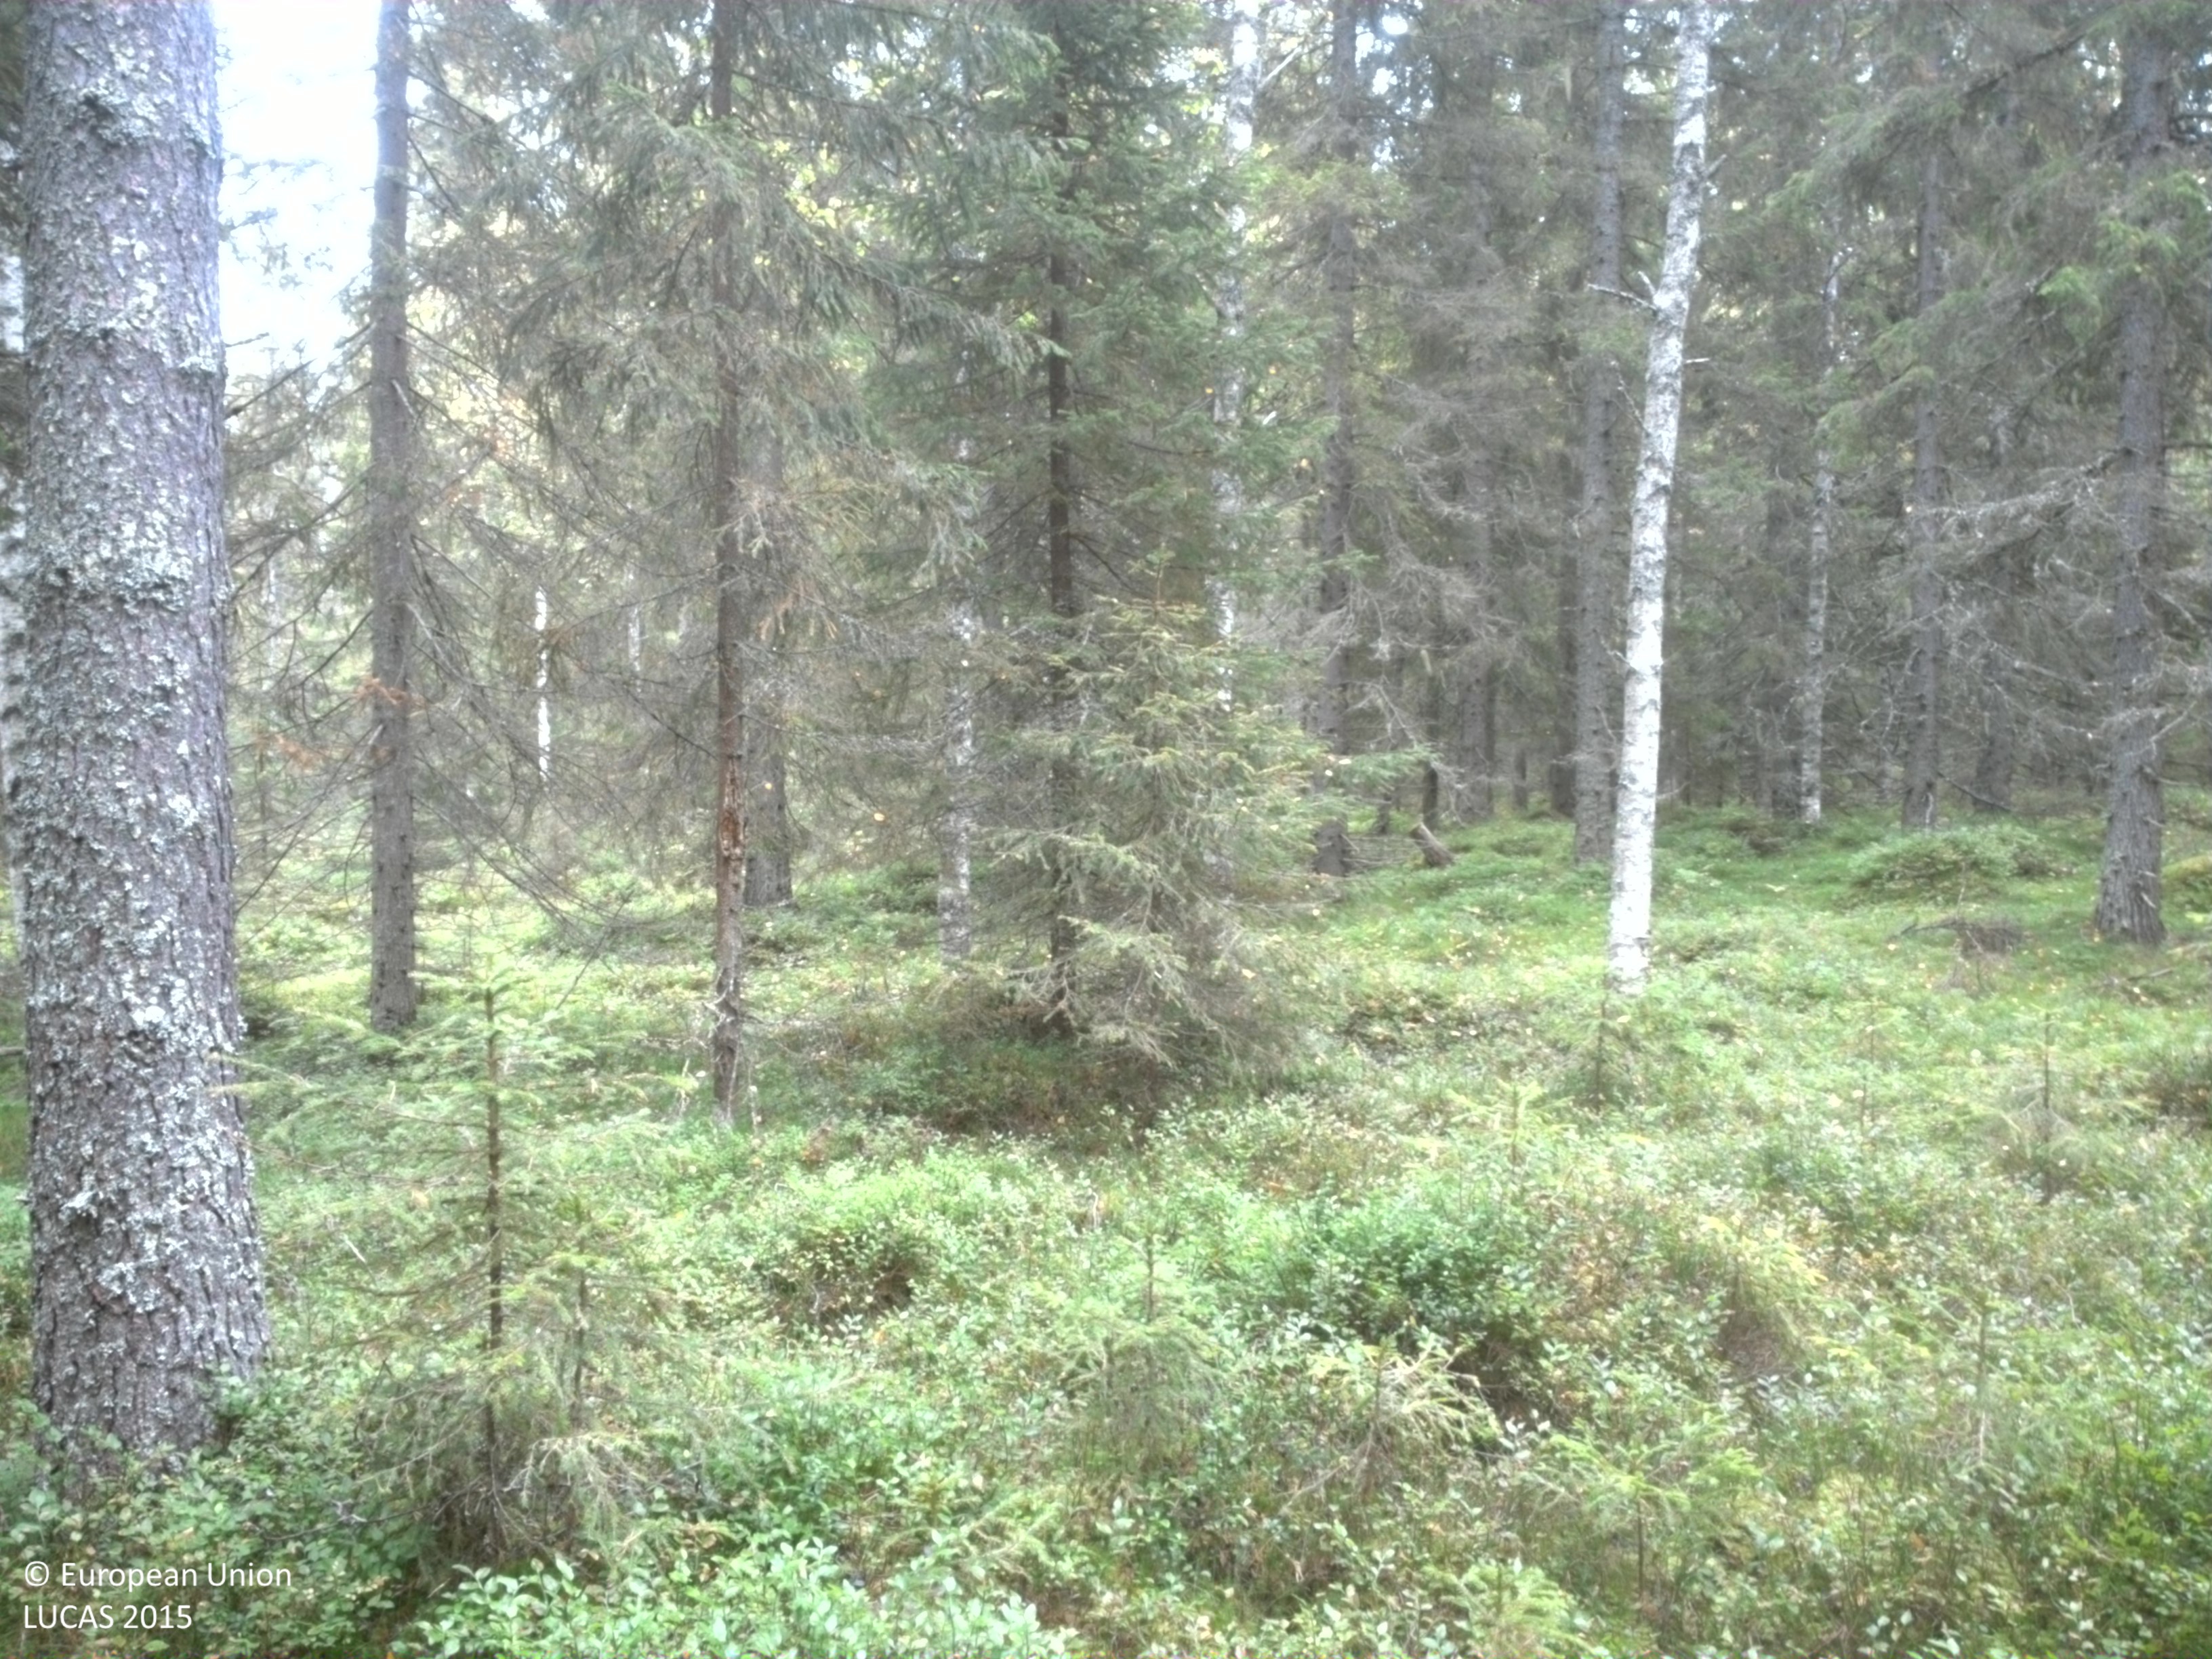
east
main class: Woodland
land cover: Other mixed woodland
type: boreal forest
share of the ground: 50 - 75 %
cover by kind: coniferous forest trees 45 %, shrubs 30 %, broadleaved forest trees 20 %, lichens and mosses 5 %
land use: Forestry
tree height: > 5 m
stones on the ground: 10 - 25 %
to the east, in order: Other mixed woodland; Shrubland with sparse tree cover; Electric lines; Shrubland with sparse tree cover; Other coniferous woodland; Paved roads, cycling and walking lanes; Other coniferous woodland
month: September
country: SE
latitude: 64.4659
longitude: 20.2683
